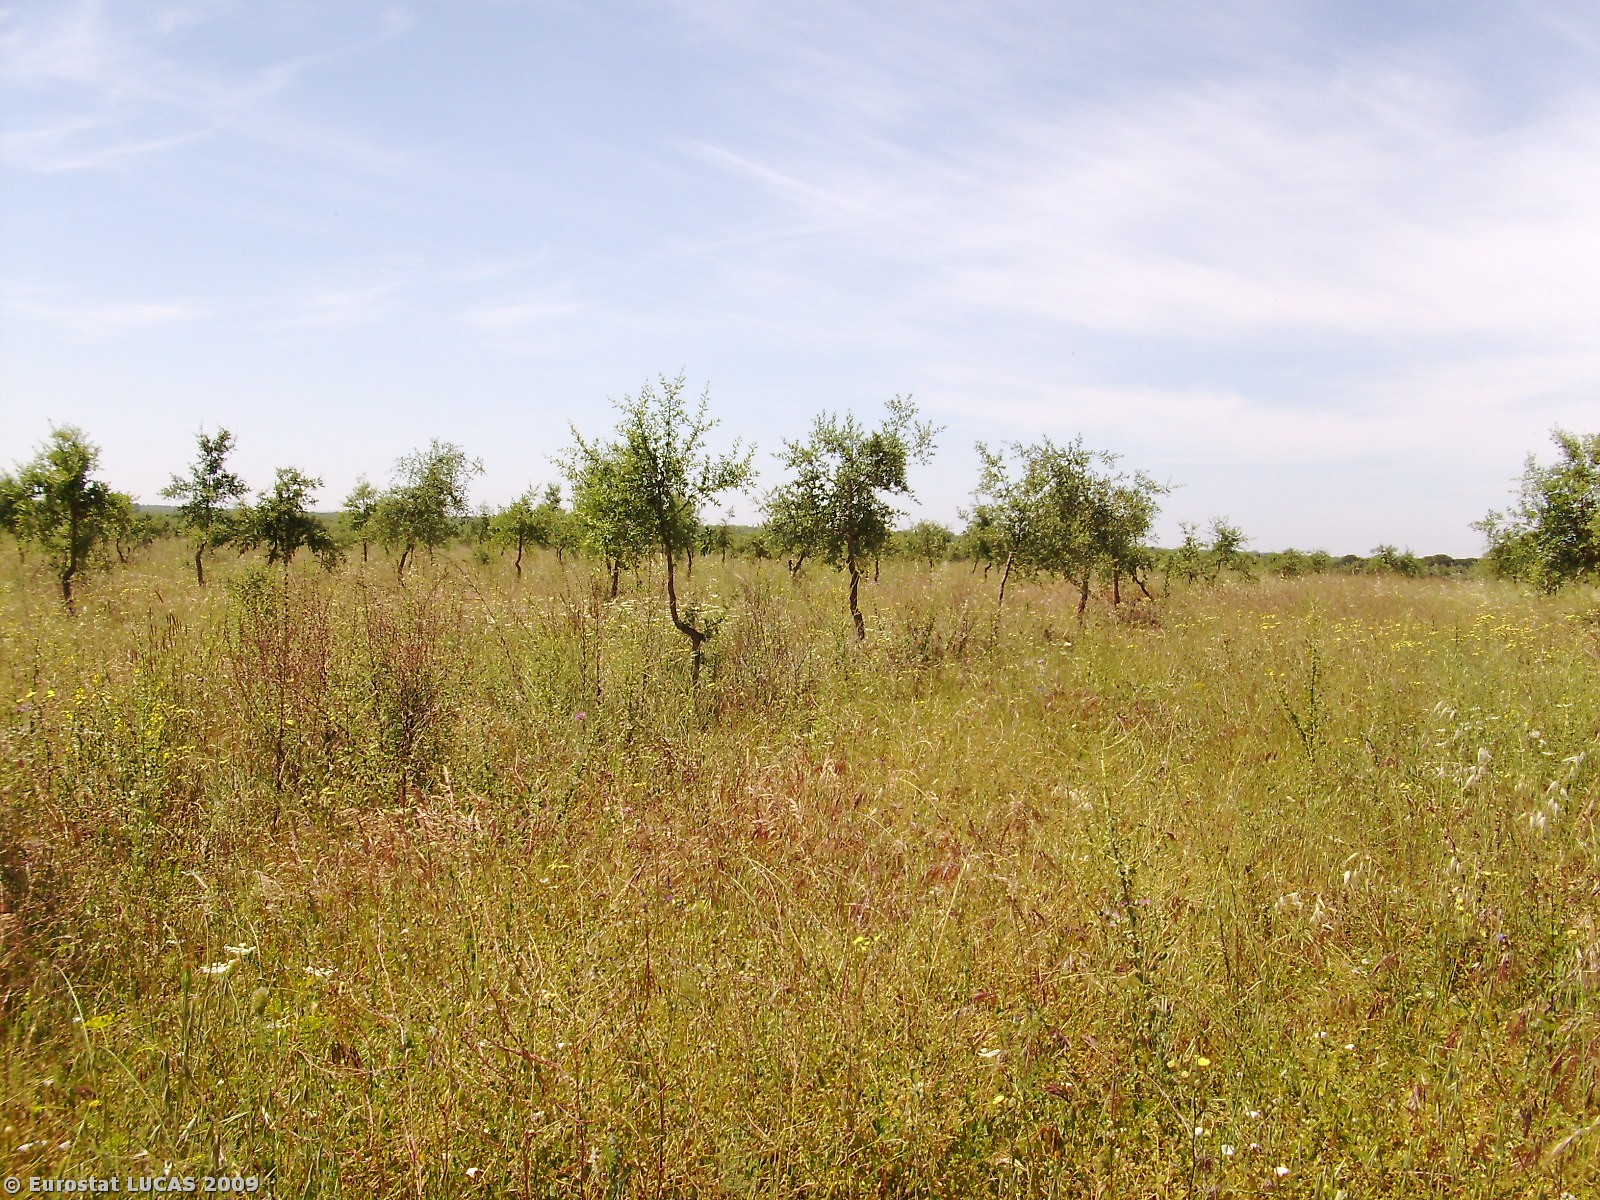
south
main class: Woodland
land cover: Broadleaved woodland
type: broadleaved evergreen forest
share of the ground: 25 - 50 %
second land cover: Spontaneously vegetated surfaces
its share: 50 - 75 %
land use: Forestry
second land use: Fallow land
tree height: > 5 m
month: May
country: PT
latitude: 39.0372
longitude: -8.0629
